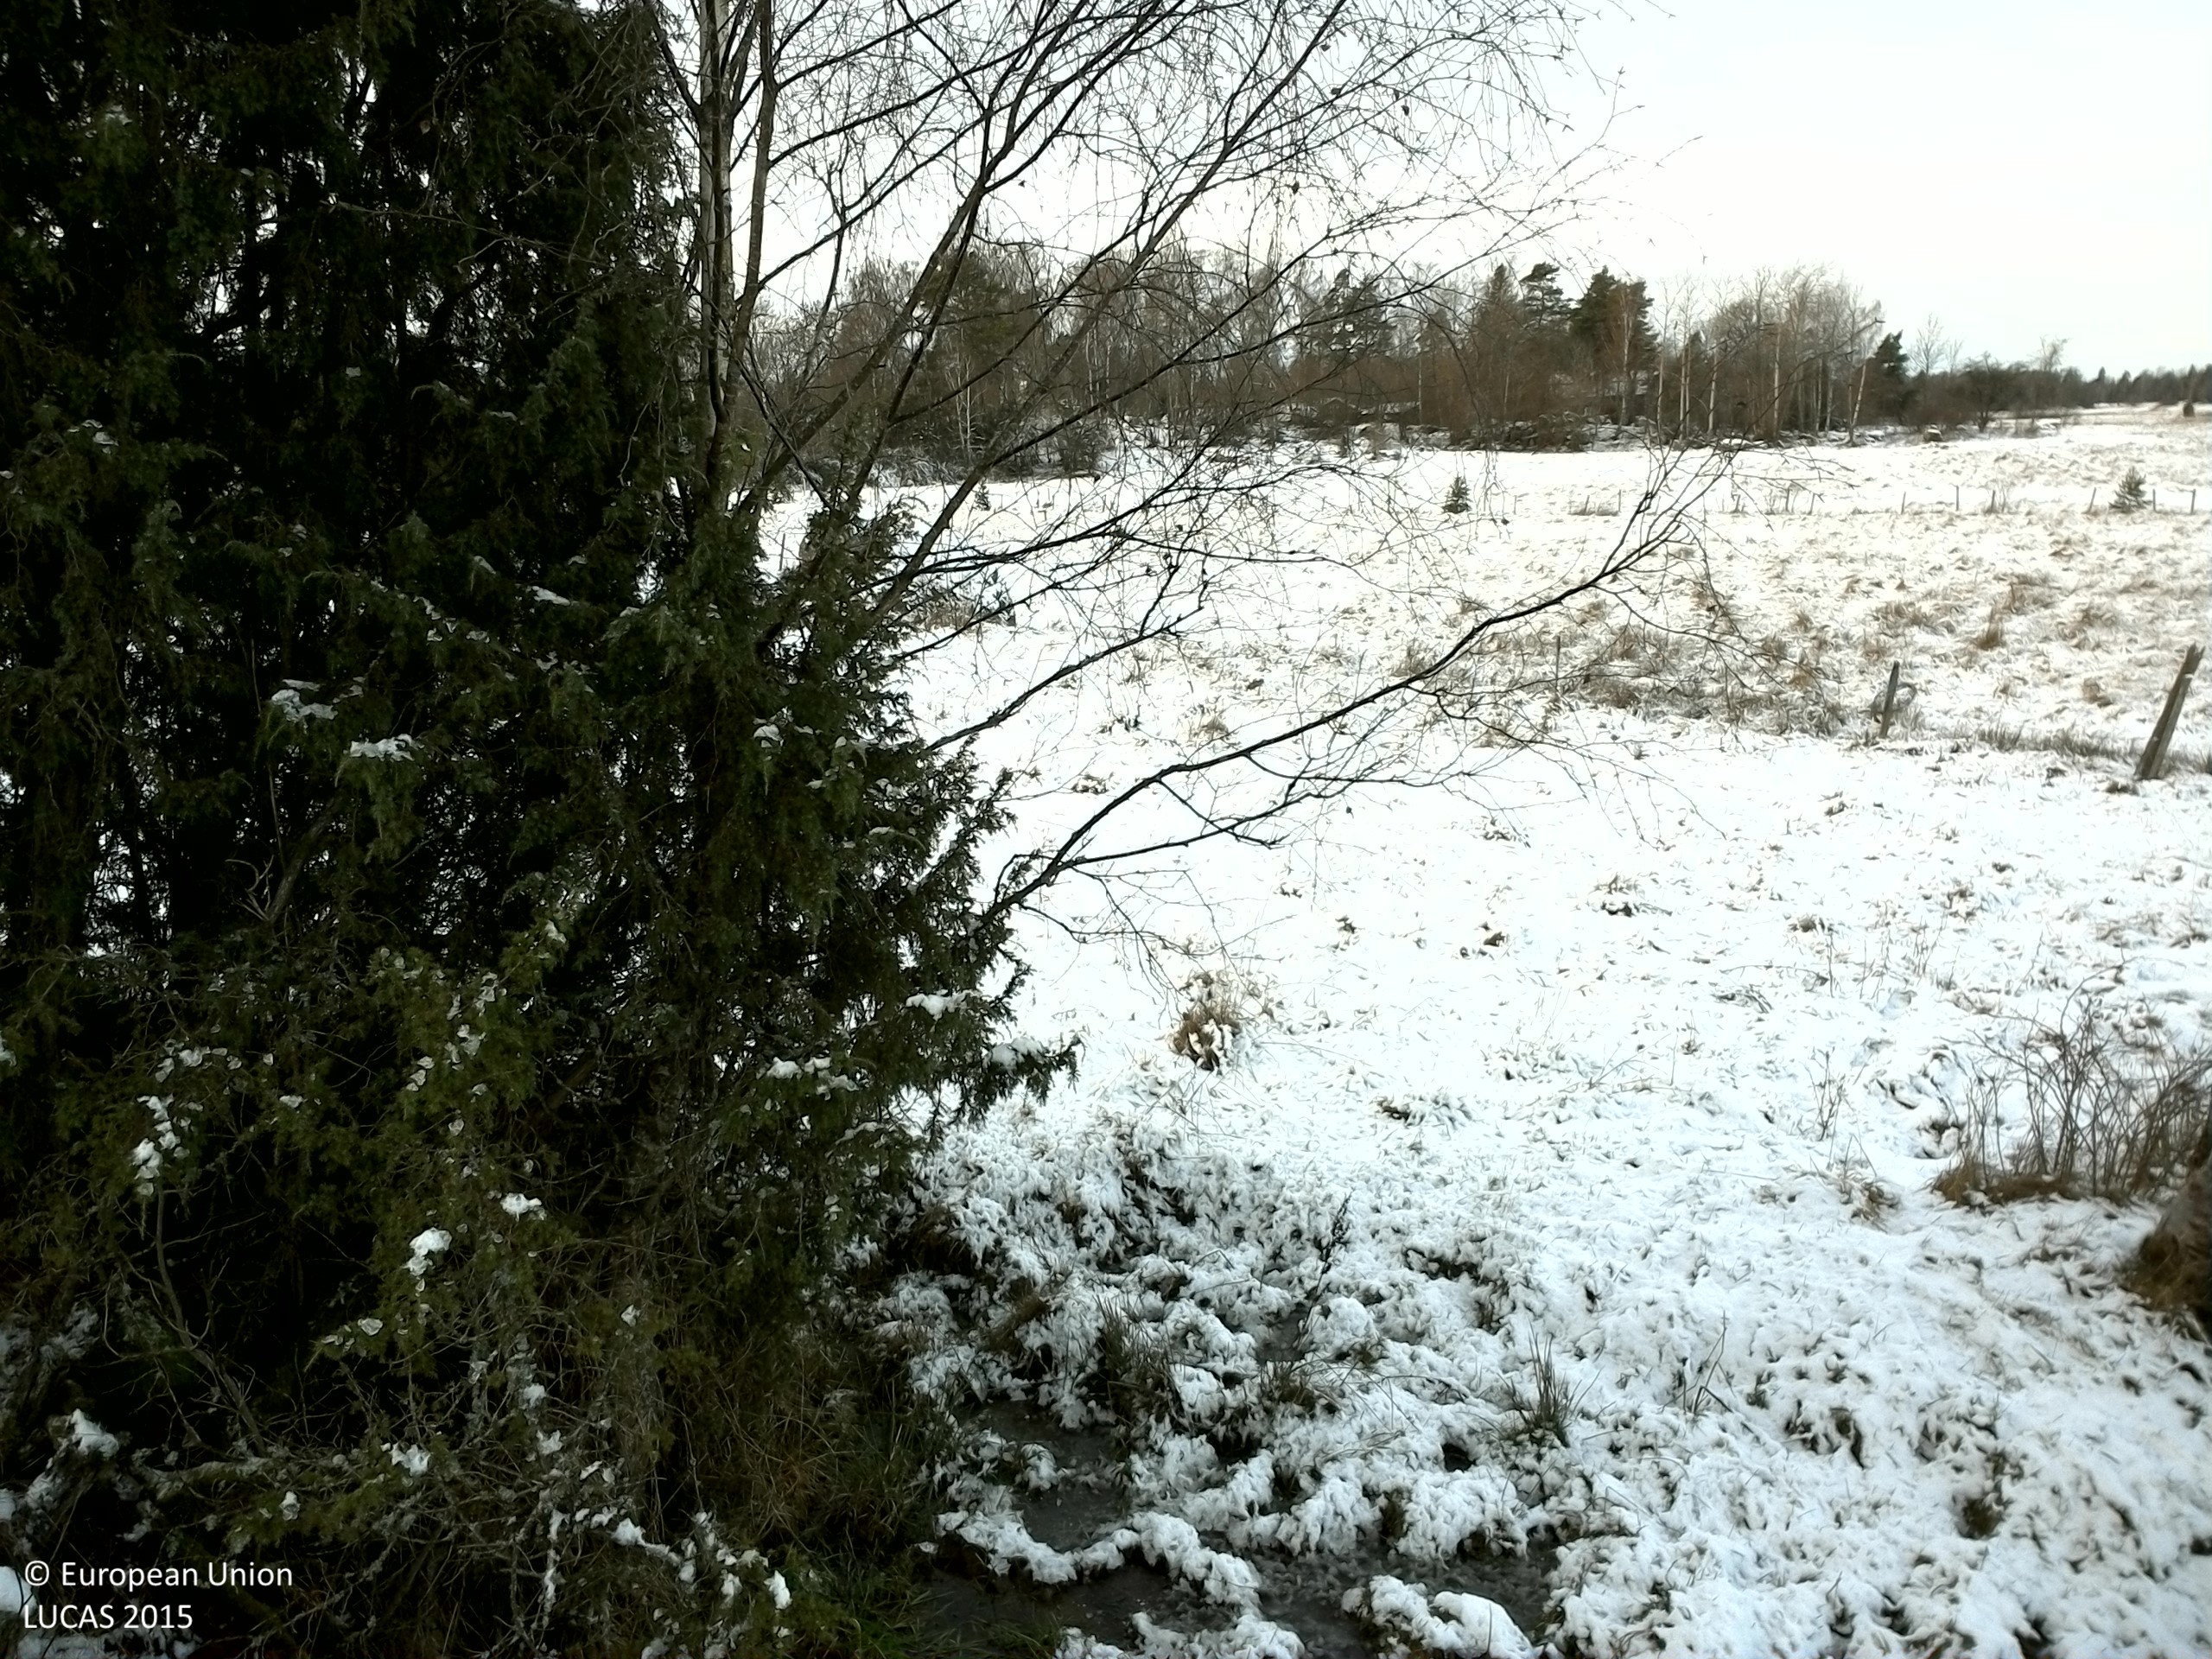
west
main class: Grassland
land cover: Grassland with sparse tree/shrub cover
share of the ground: > 75 %
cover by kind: herbaceous plants 90 %, broadleaved forest trees 5 %, shrubs 5 %
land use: Agriculture (excluding fallow land and kitchen gardens)
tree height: > 5 m
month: December
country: SE
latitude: 59.5292
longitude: 16.4099
